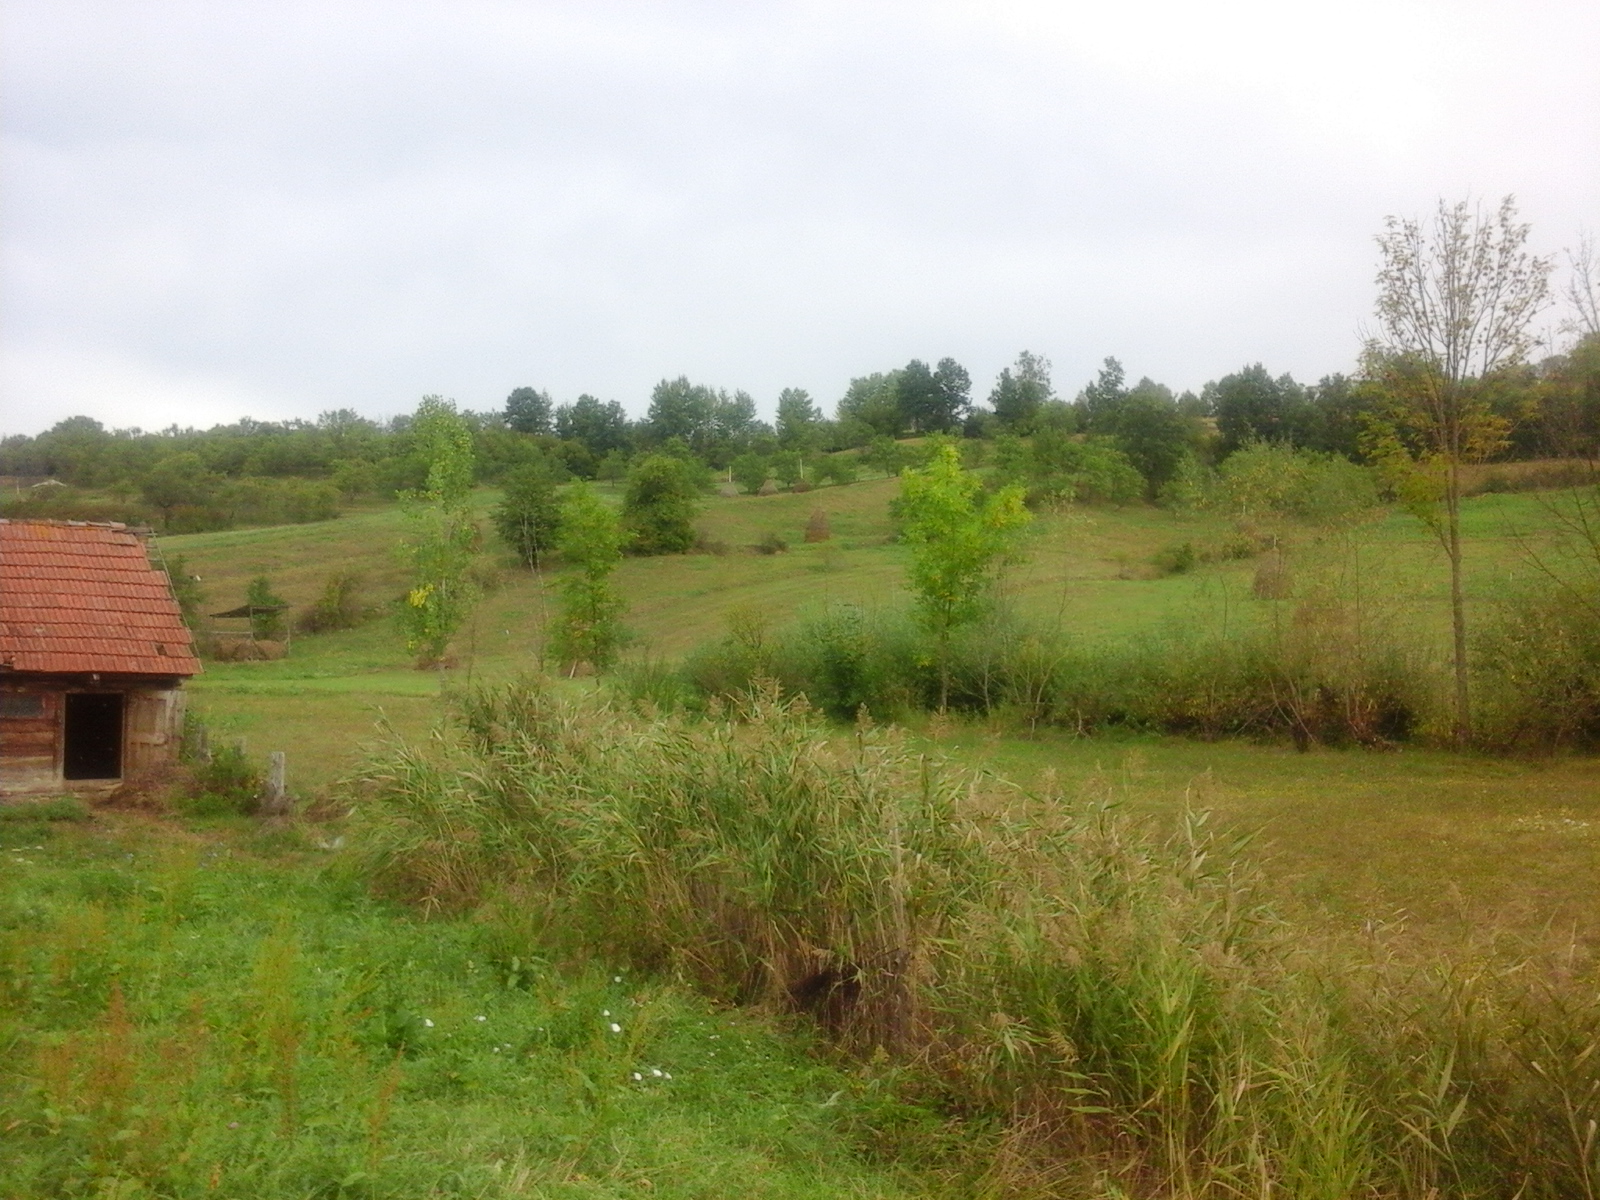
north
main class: Grassland
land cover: Grassland with sparse tree/shrub cover
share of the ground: < 10 %
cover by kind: herbaceous plants 95 %, broadleaved forest trees 5 %
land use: Agriculture (excluding fallow land and kitchen gardens)
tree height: > 5 m
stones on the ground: < 10 %
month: September
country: RO
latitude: 47.7526
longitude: 24.0791
